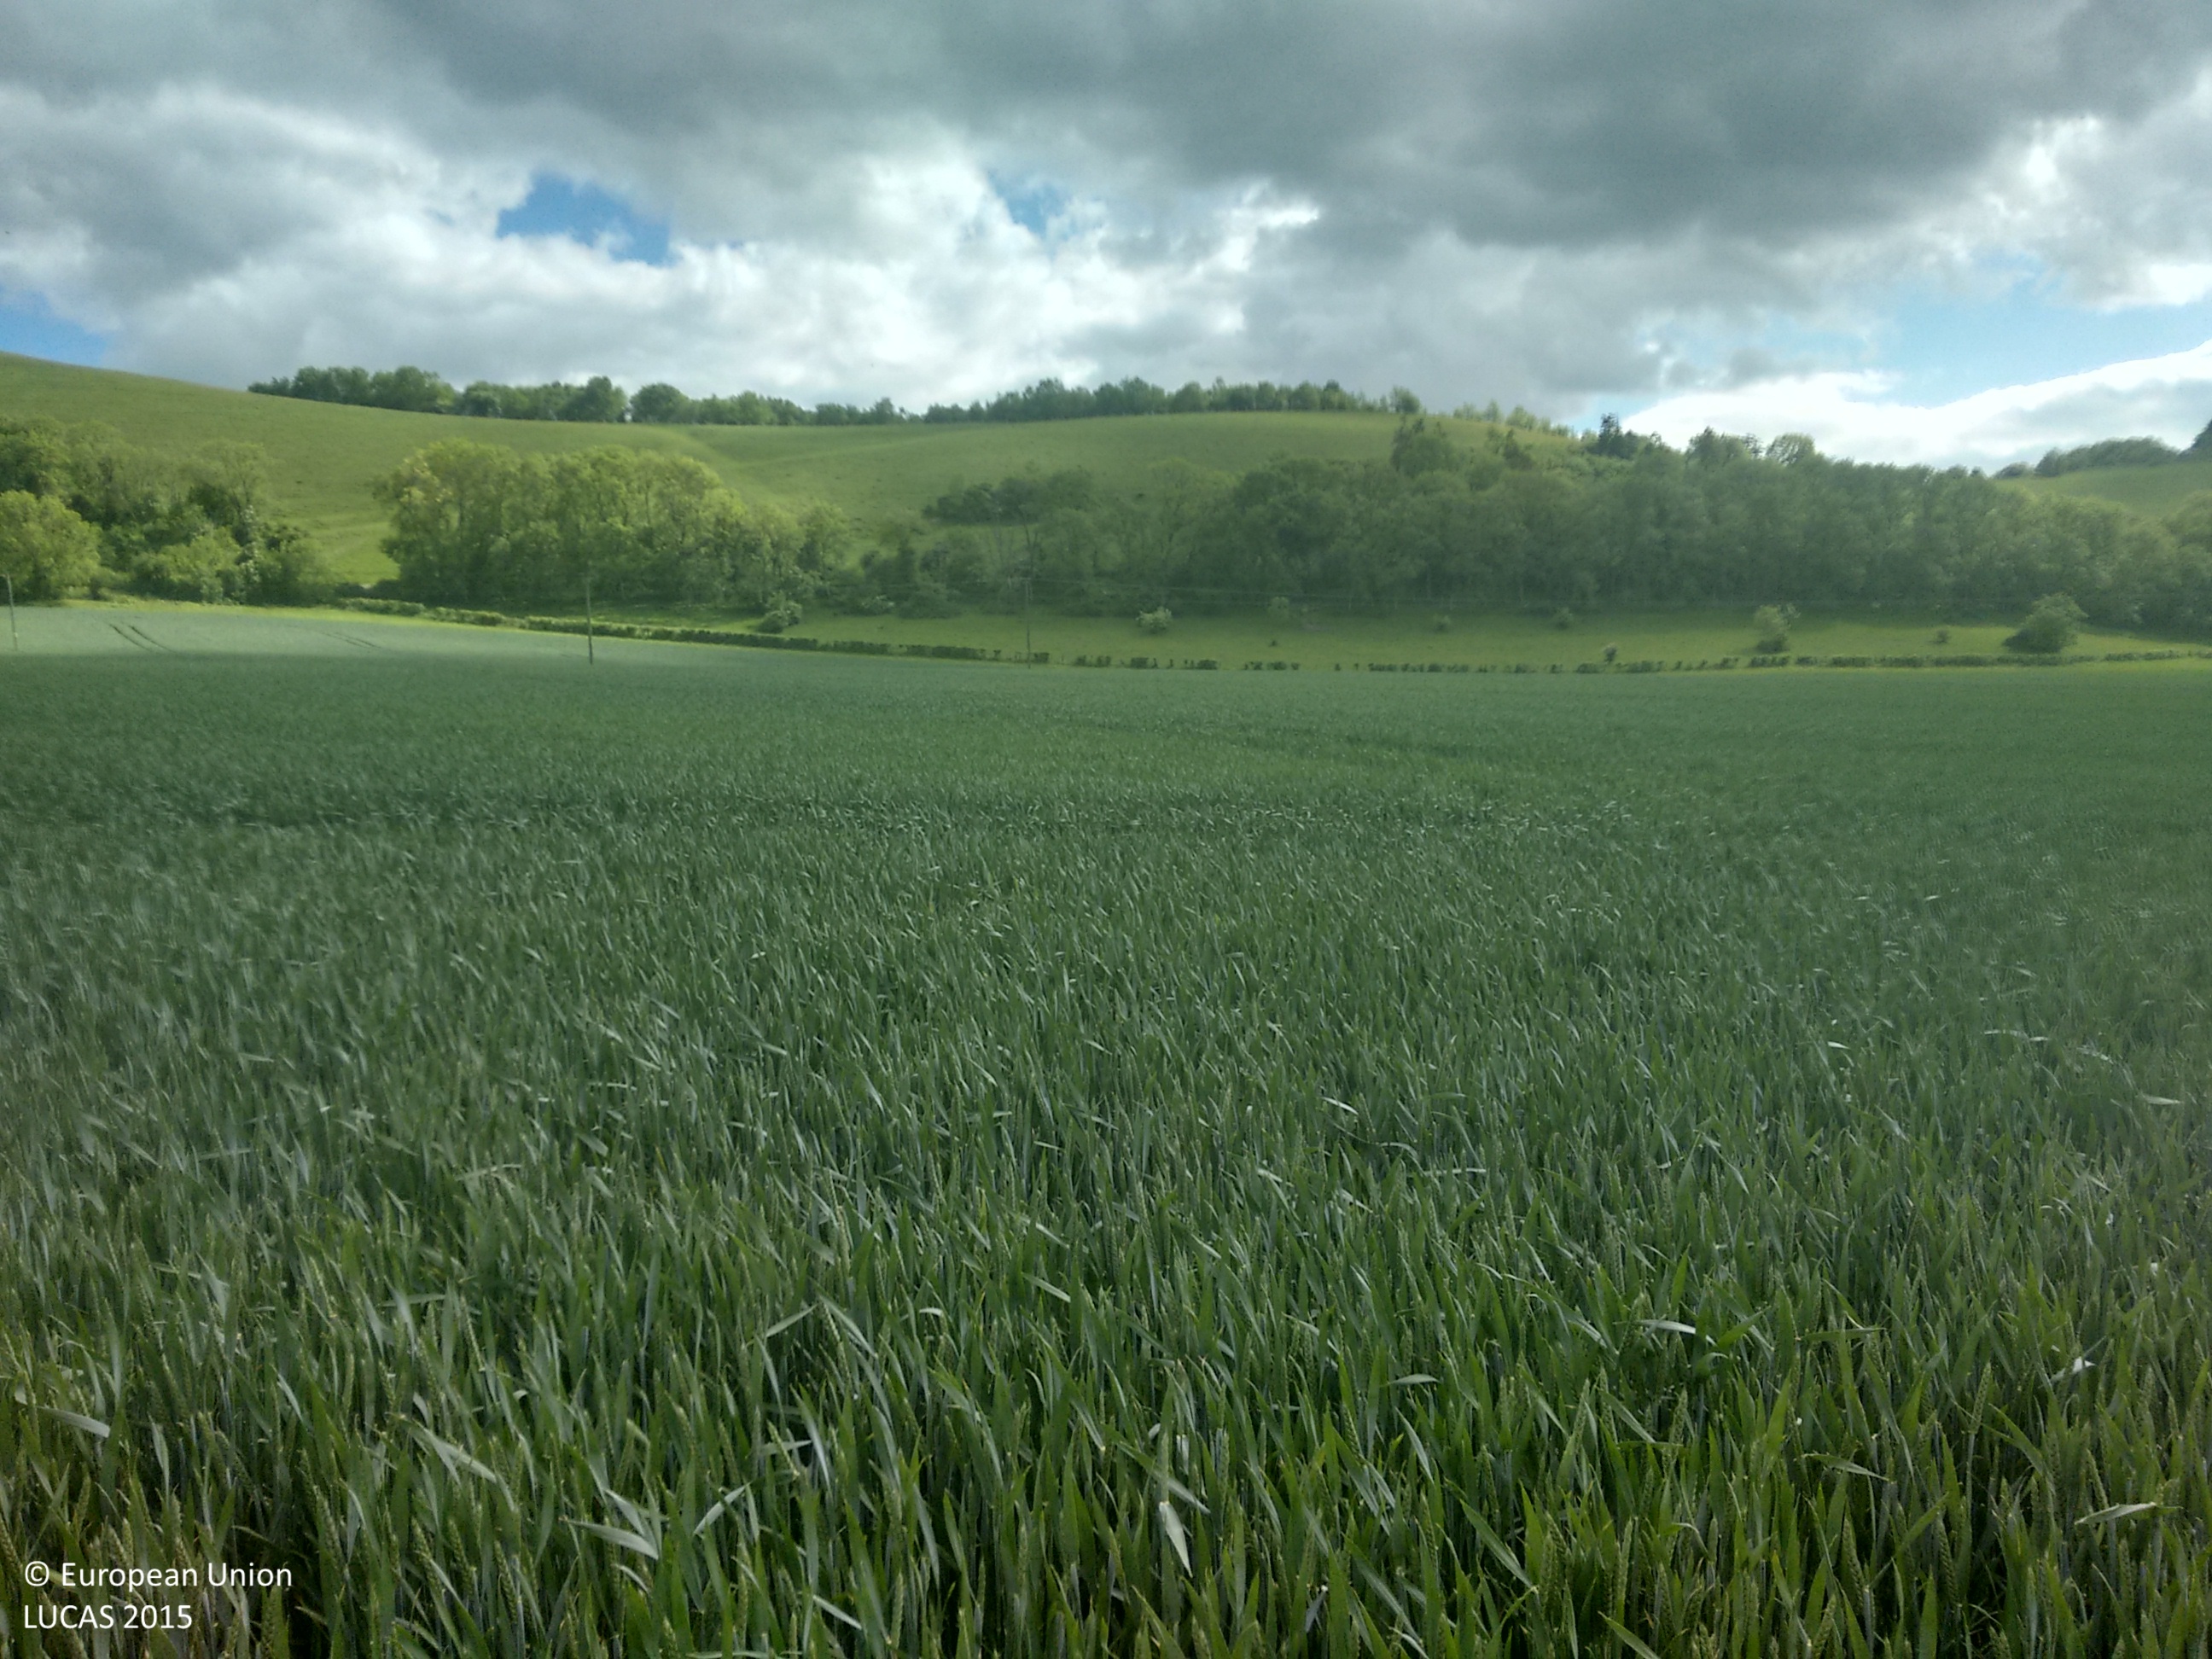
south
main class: Cropland
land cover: Common wheat
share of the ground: > 75 %
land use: Agriculture (excluding fallow land and kitchen gardens)
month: June
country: GB
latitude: 50.9920
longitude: -2.0988
